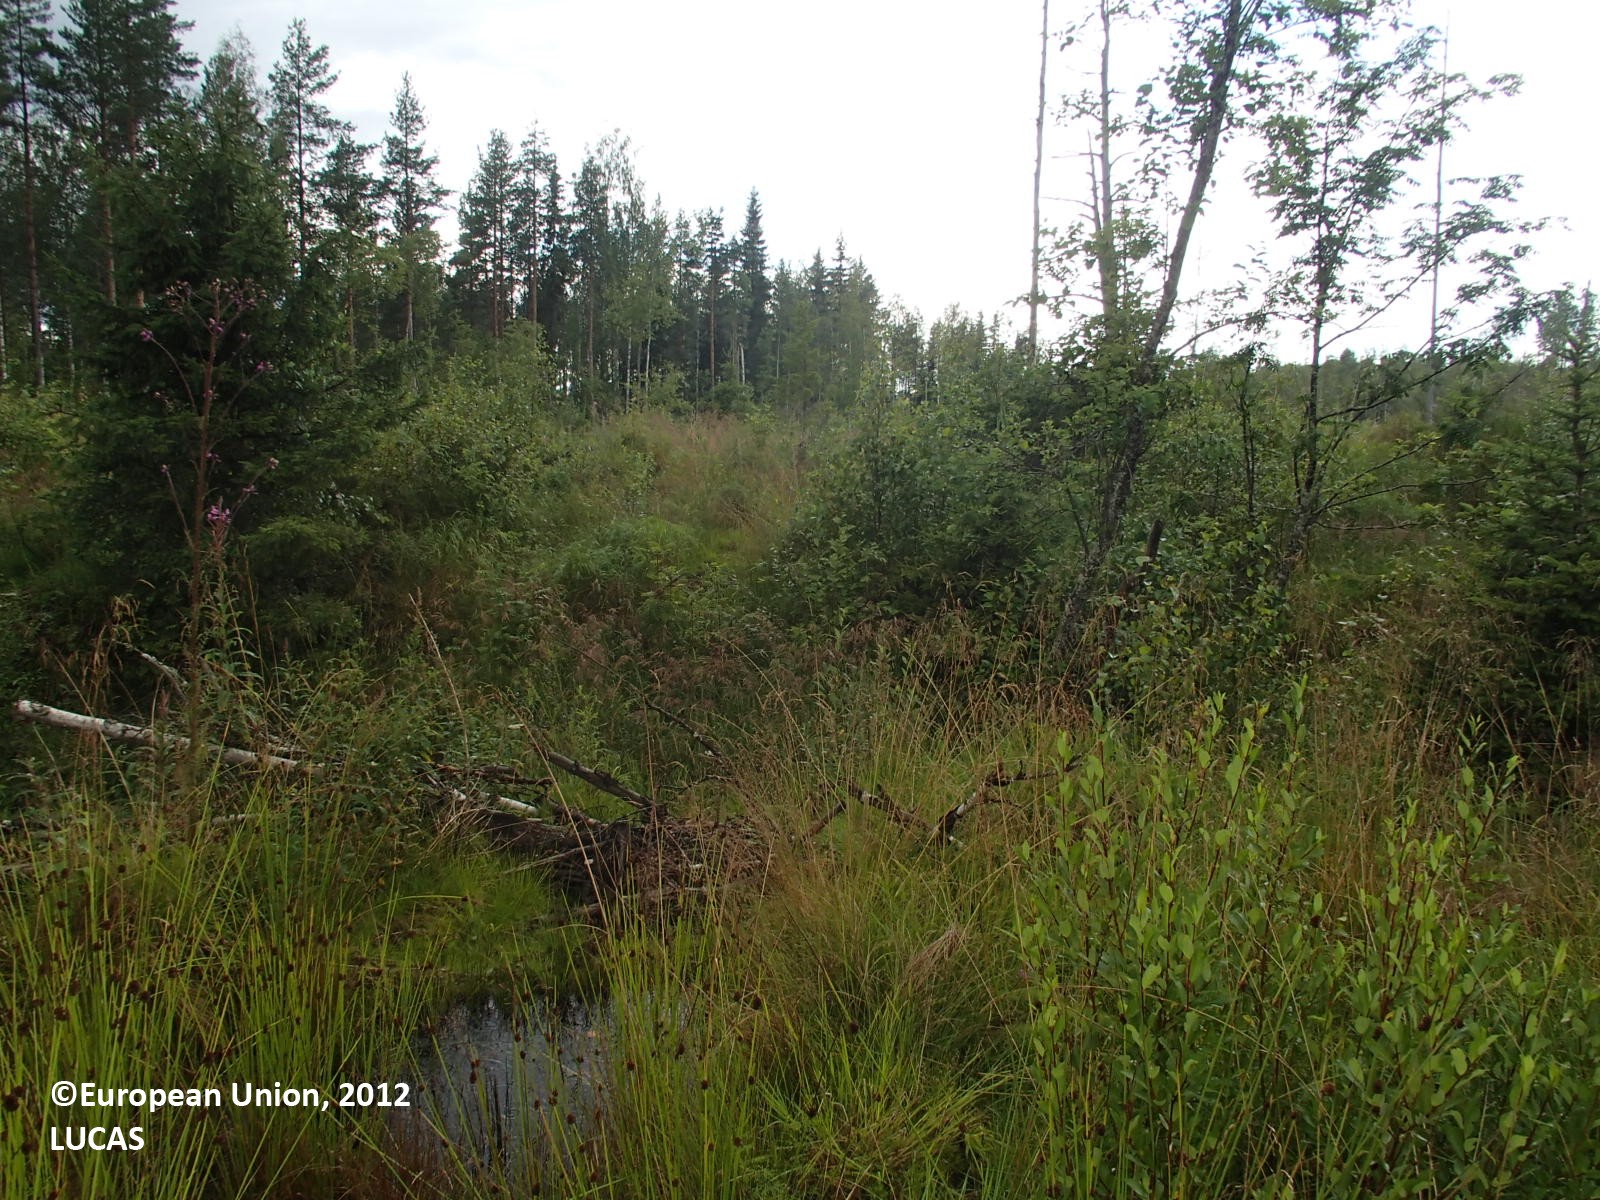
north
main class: Woodland
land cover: Spruce dominated mixed woodland
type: boreal forest
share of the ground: > 75 %
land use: Forestry
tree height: < 5 m
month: August
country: FI
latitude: 64.1144
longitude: 26.1859
